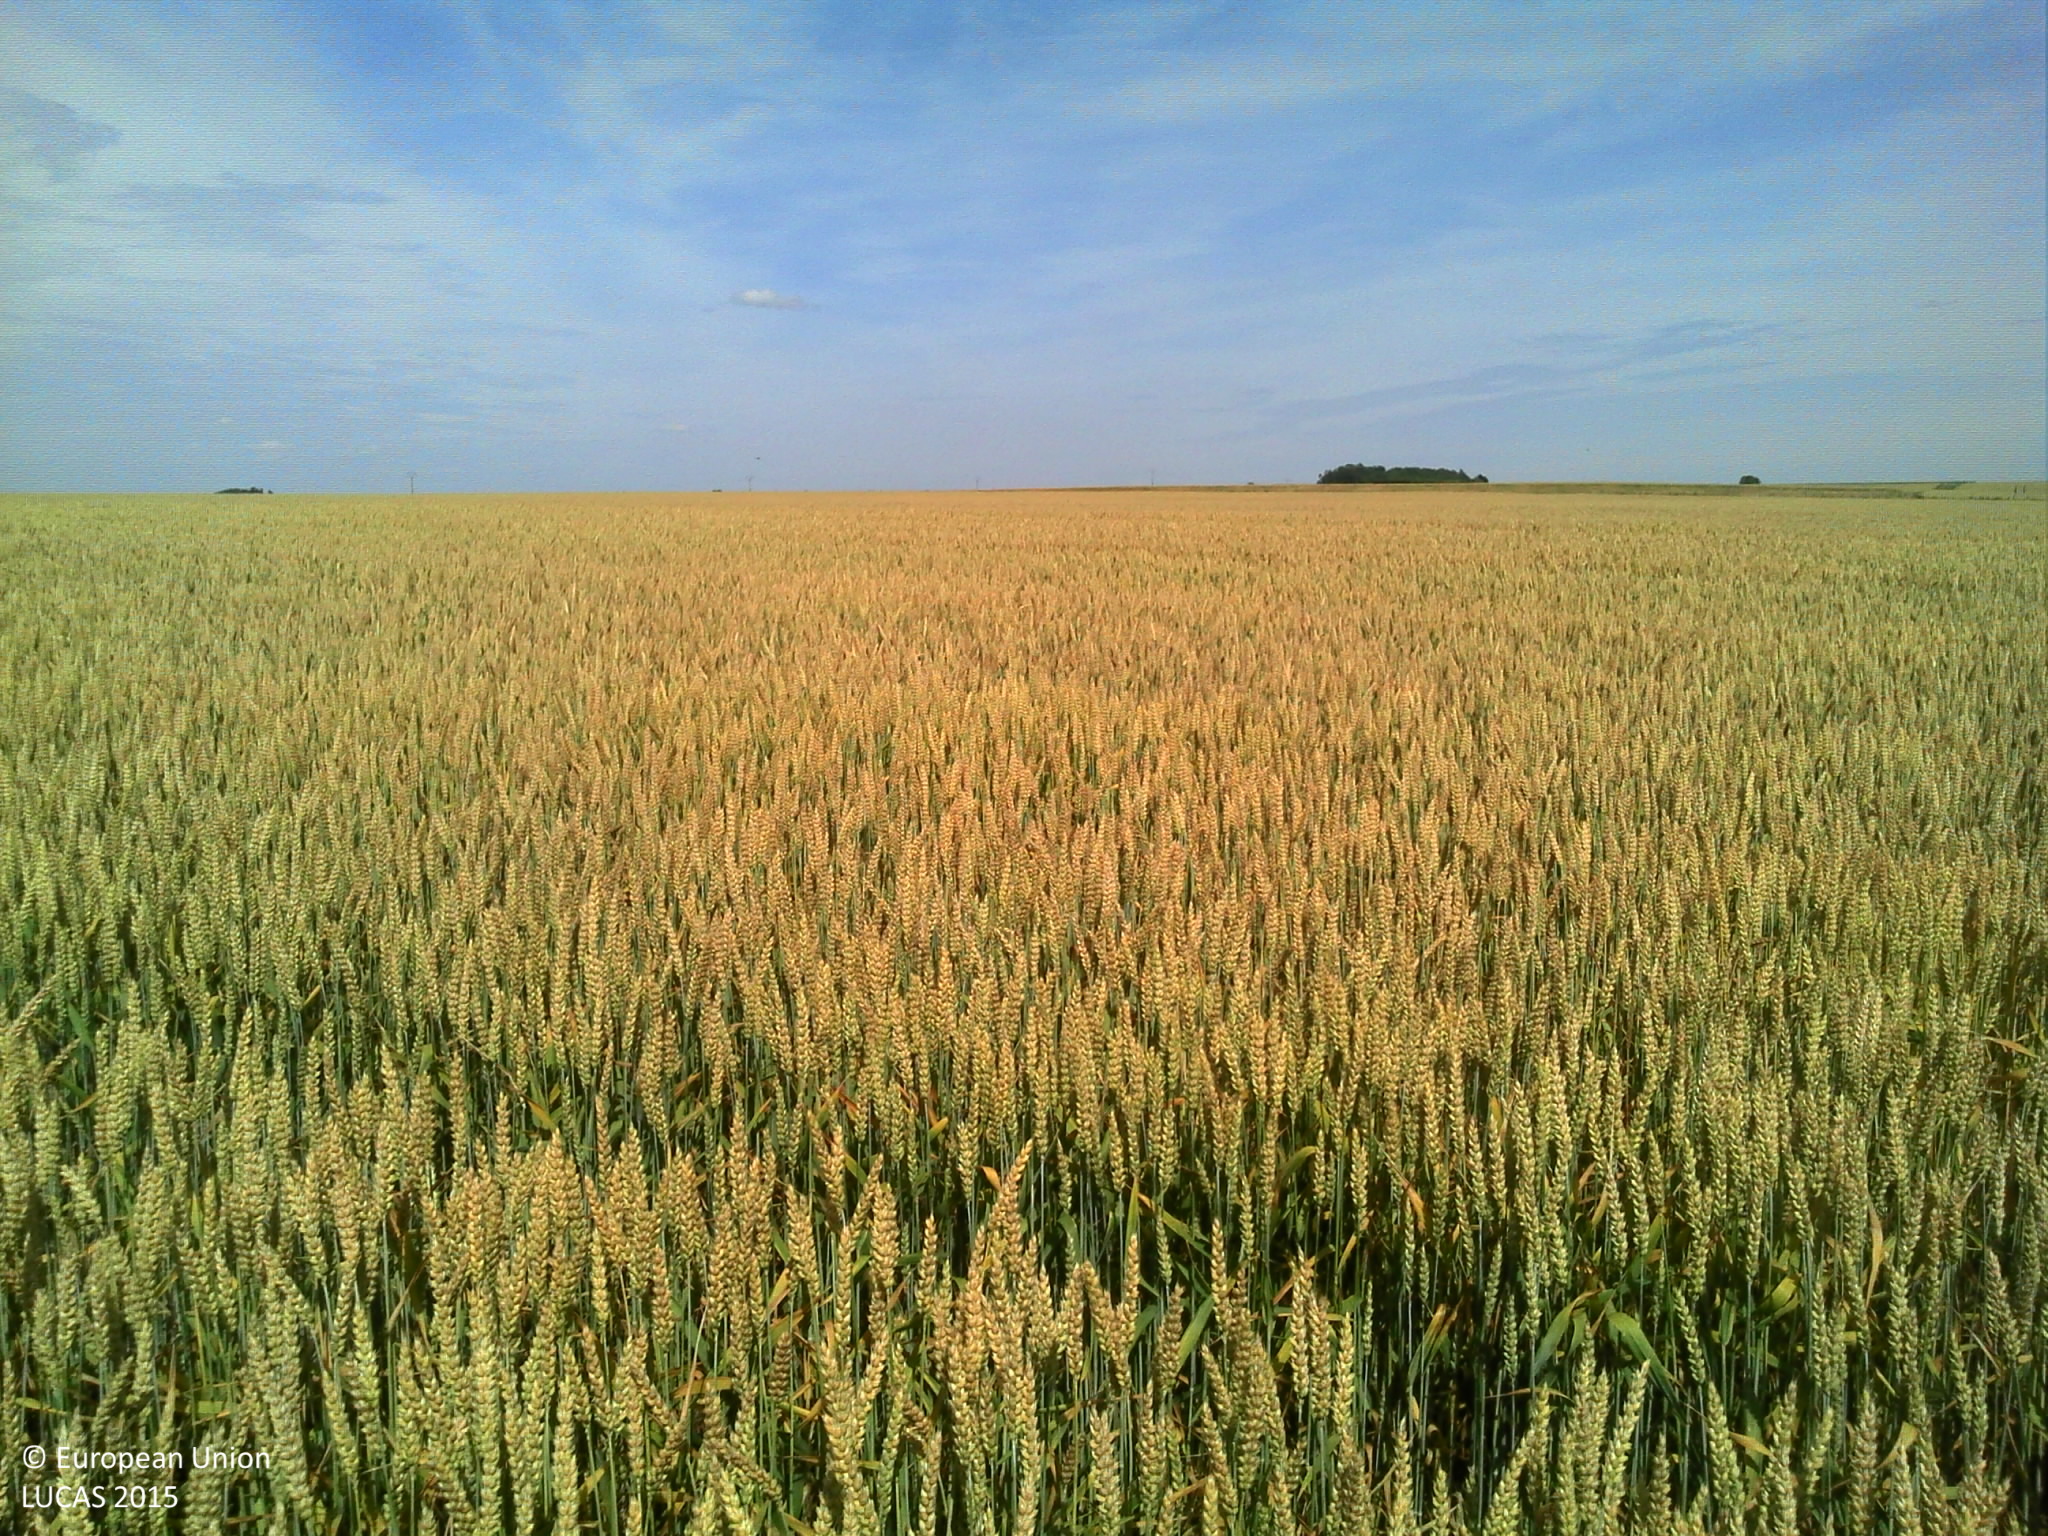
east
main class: Cropland
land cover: Common wheat
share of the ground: > 75 %
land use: Agriculture (excluding fallow land and kitchen gardens)
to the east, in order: Common wheat; Grassland without tree/shrub cover
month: June
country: FR
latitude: 46.6634
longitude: 0.2166
